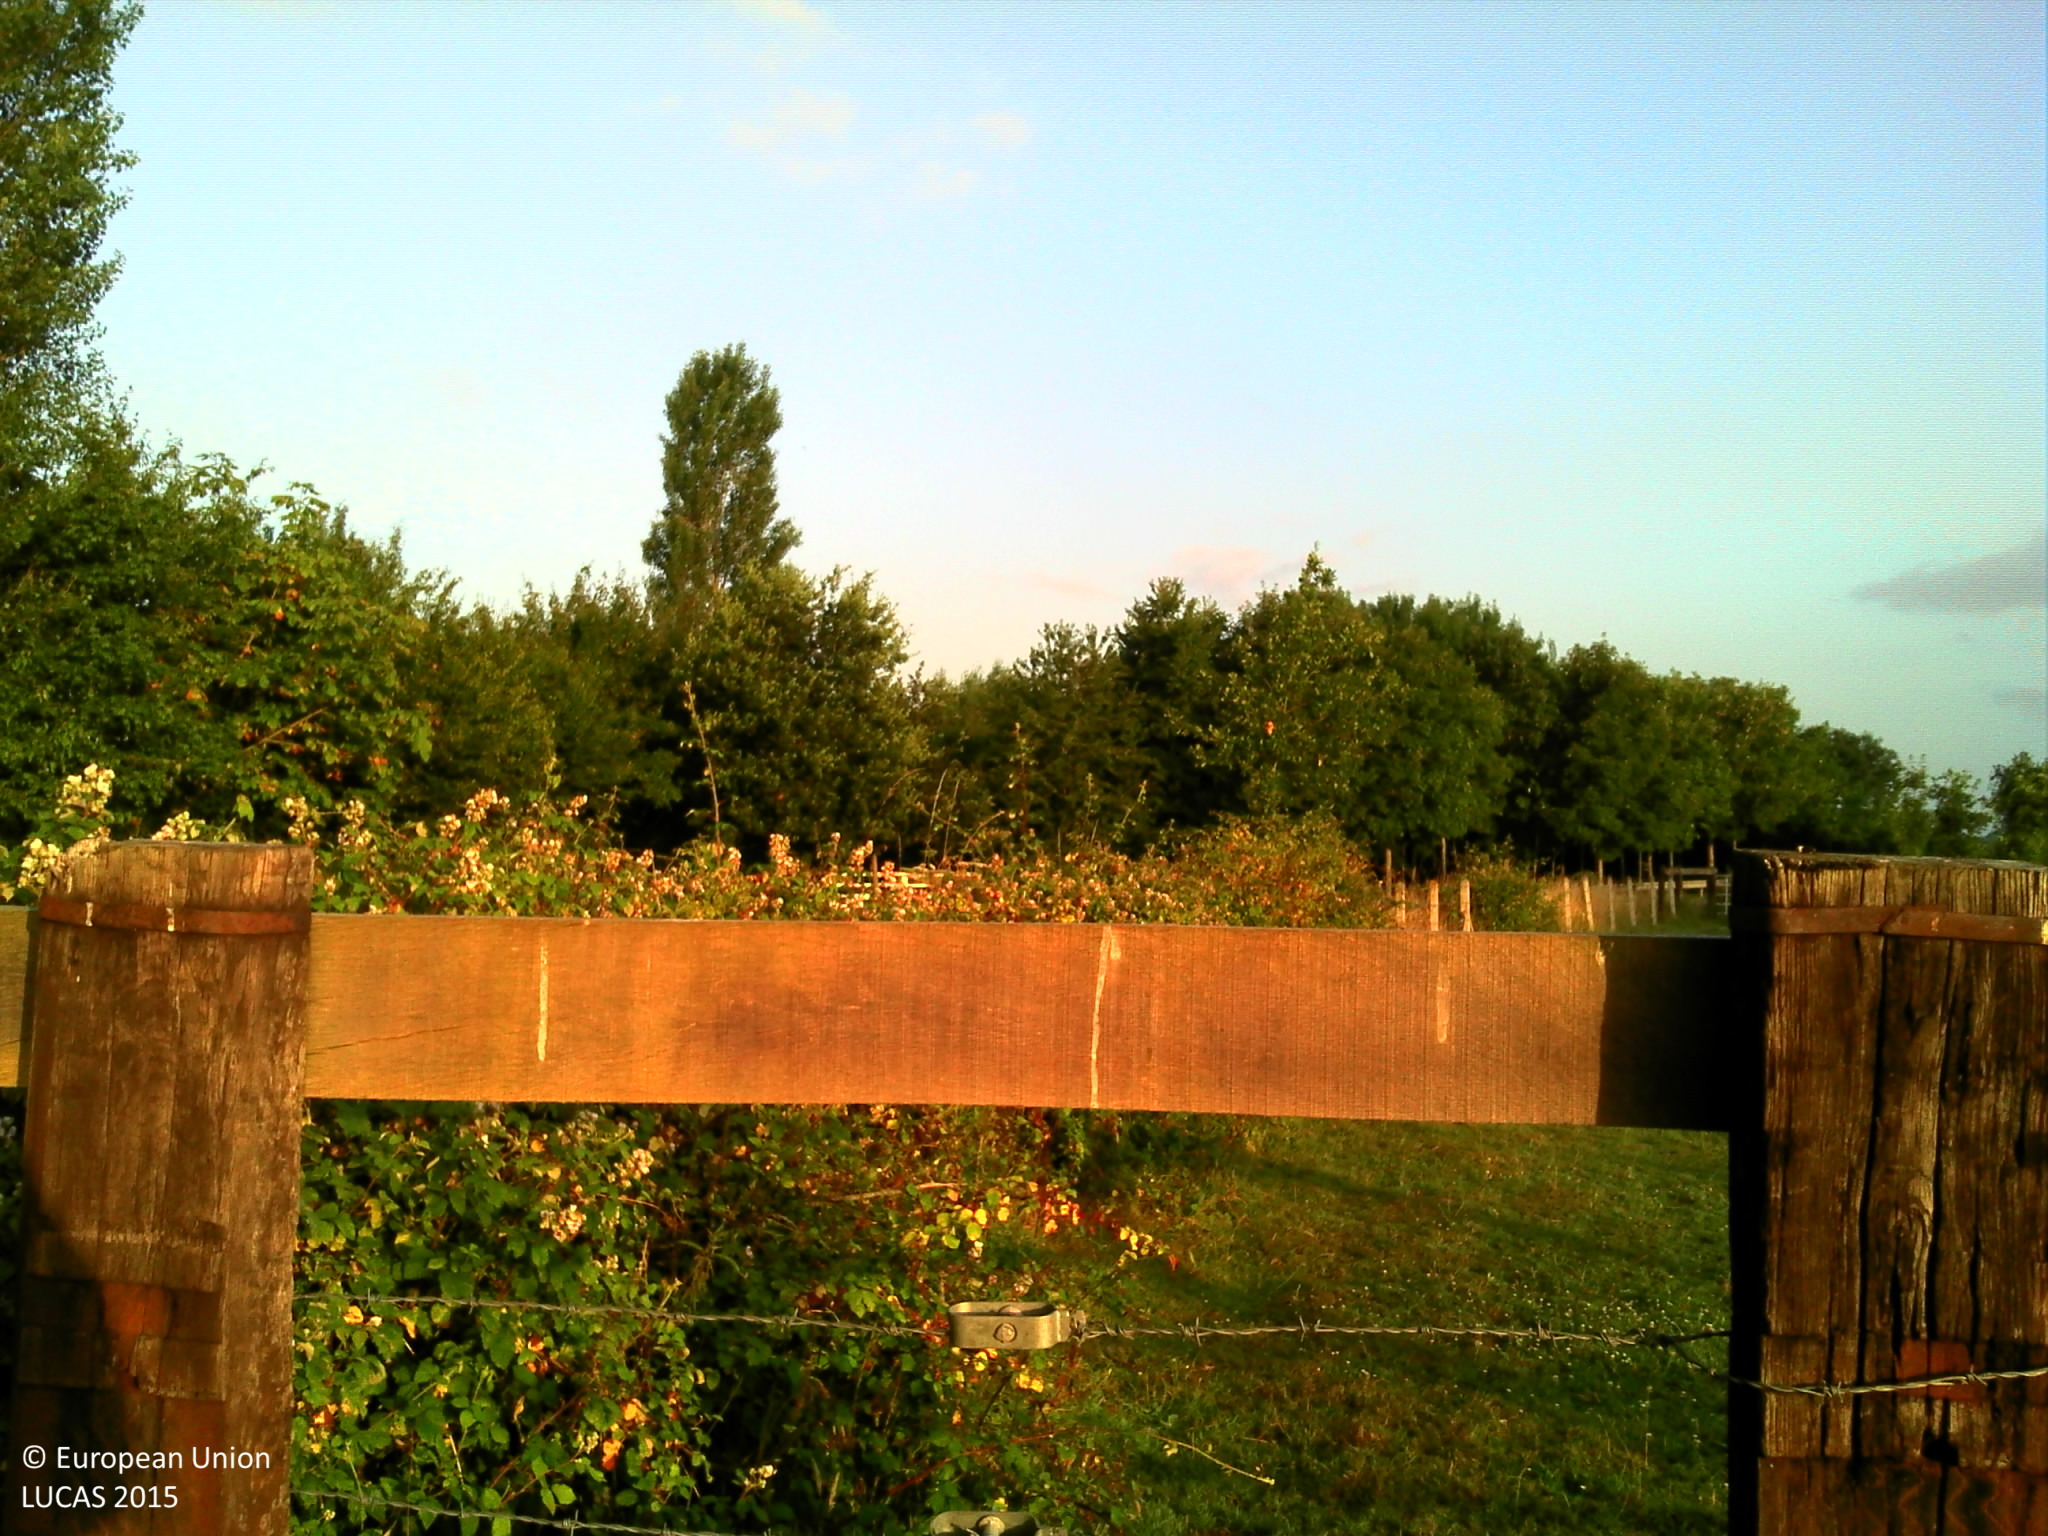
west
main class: Grassland
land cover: Grassland without tree/shrub cover
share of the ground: > 75 %
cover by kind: herbaceous plants 100 %
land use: Agriculture (excluding fallow land and kitchen gardens)
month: July
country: FR
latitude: 49.0947
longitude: 0.0407
